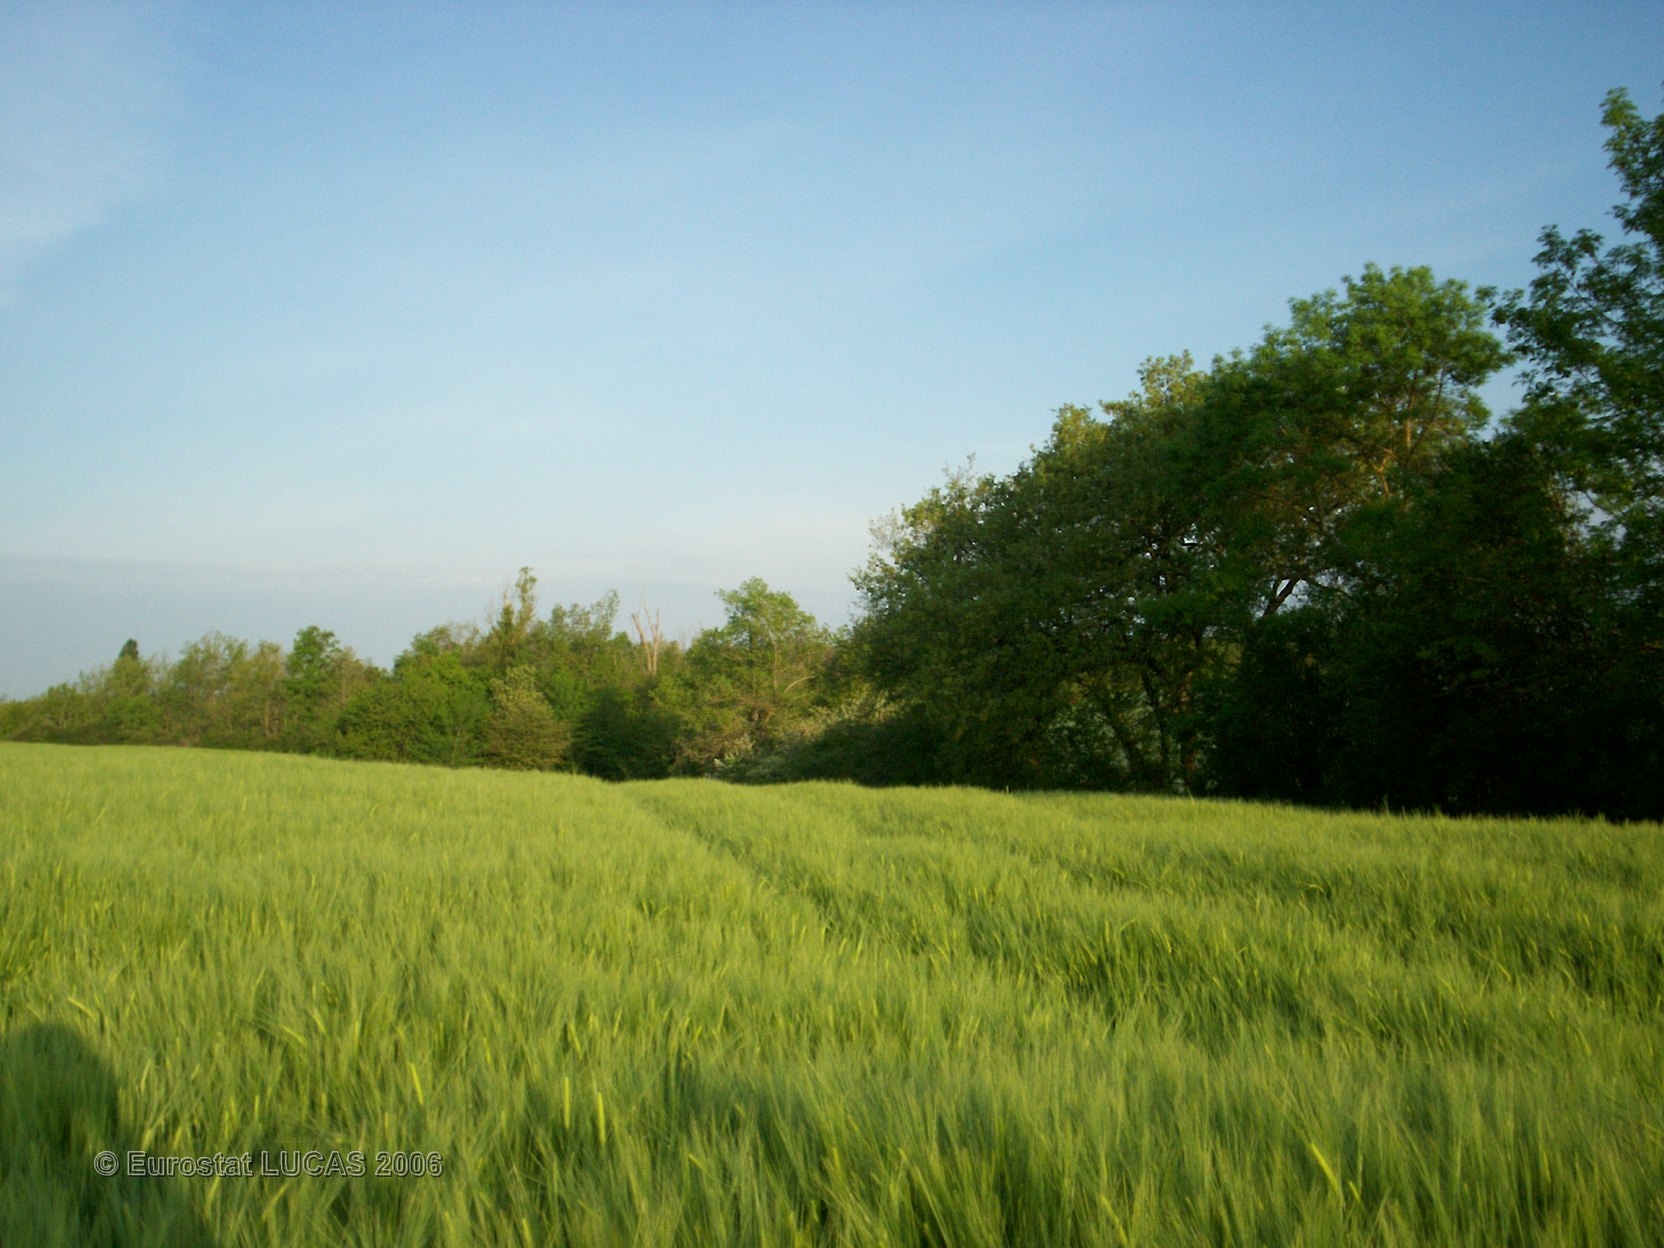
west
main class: Cropland
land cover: Barley
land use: Agriculture (excluding fallow land and kitchen gardens)
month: May
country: FR
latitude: 43.7651
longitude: 0.2685
